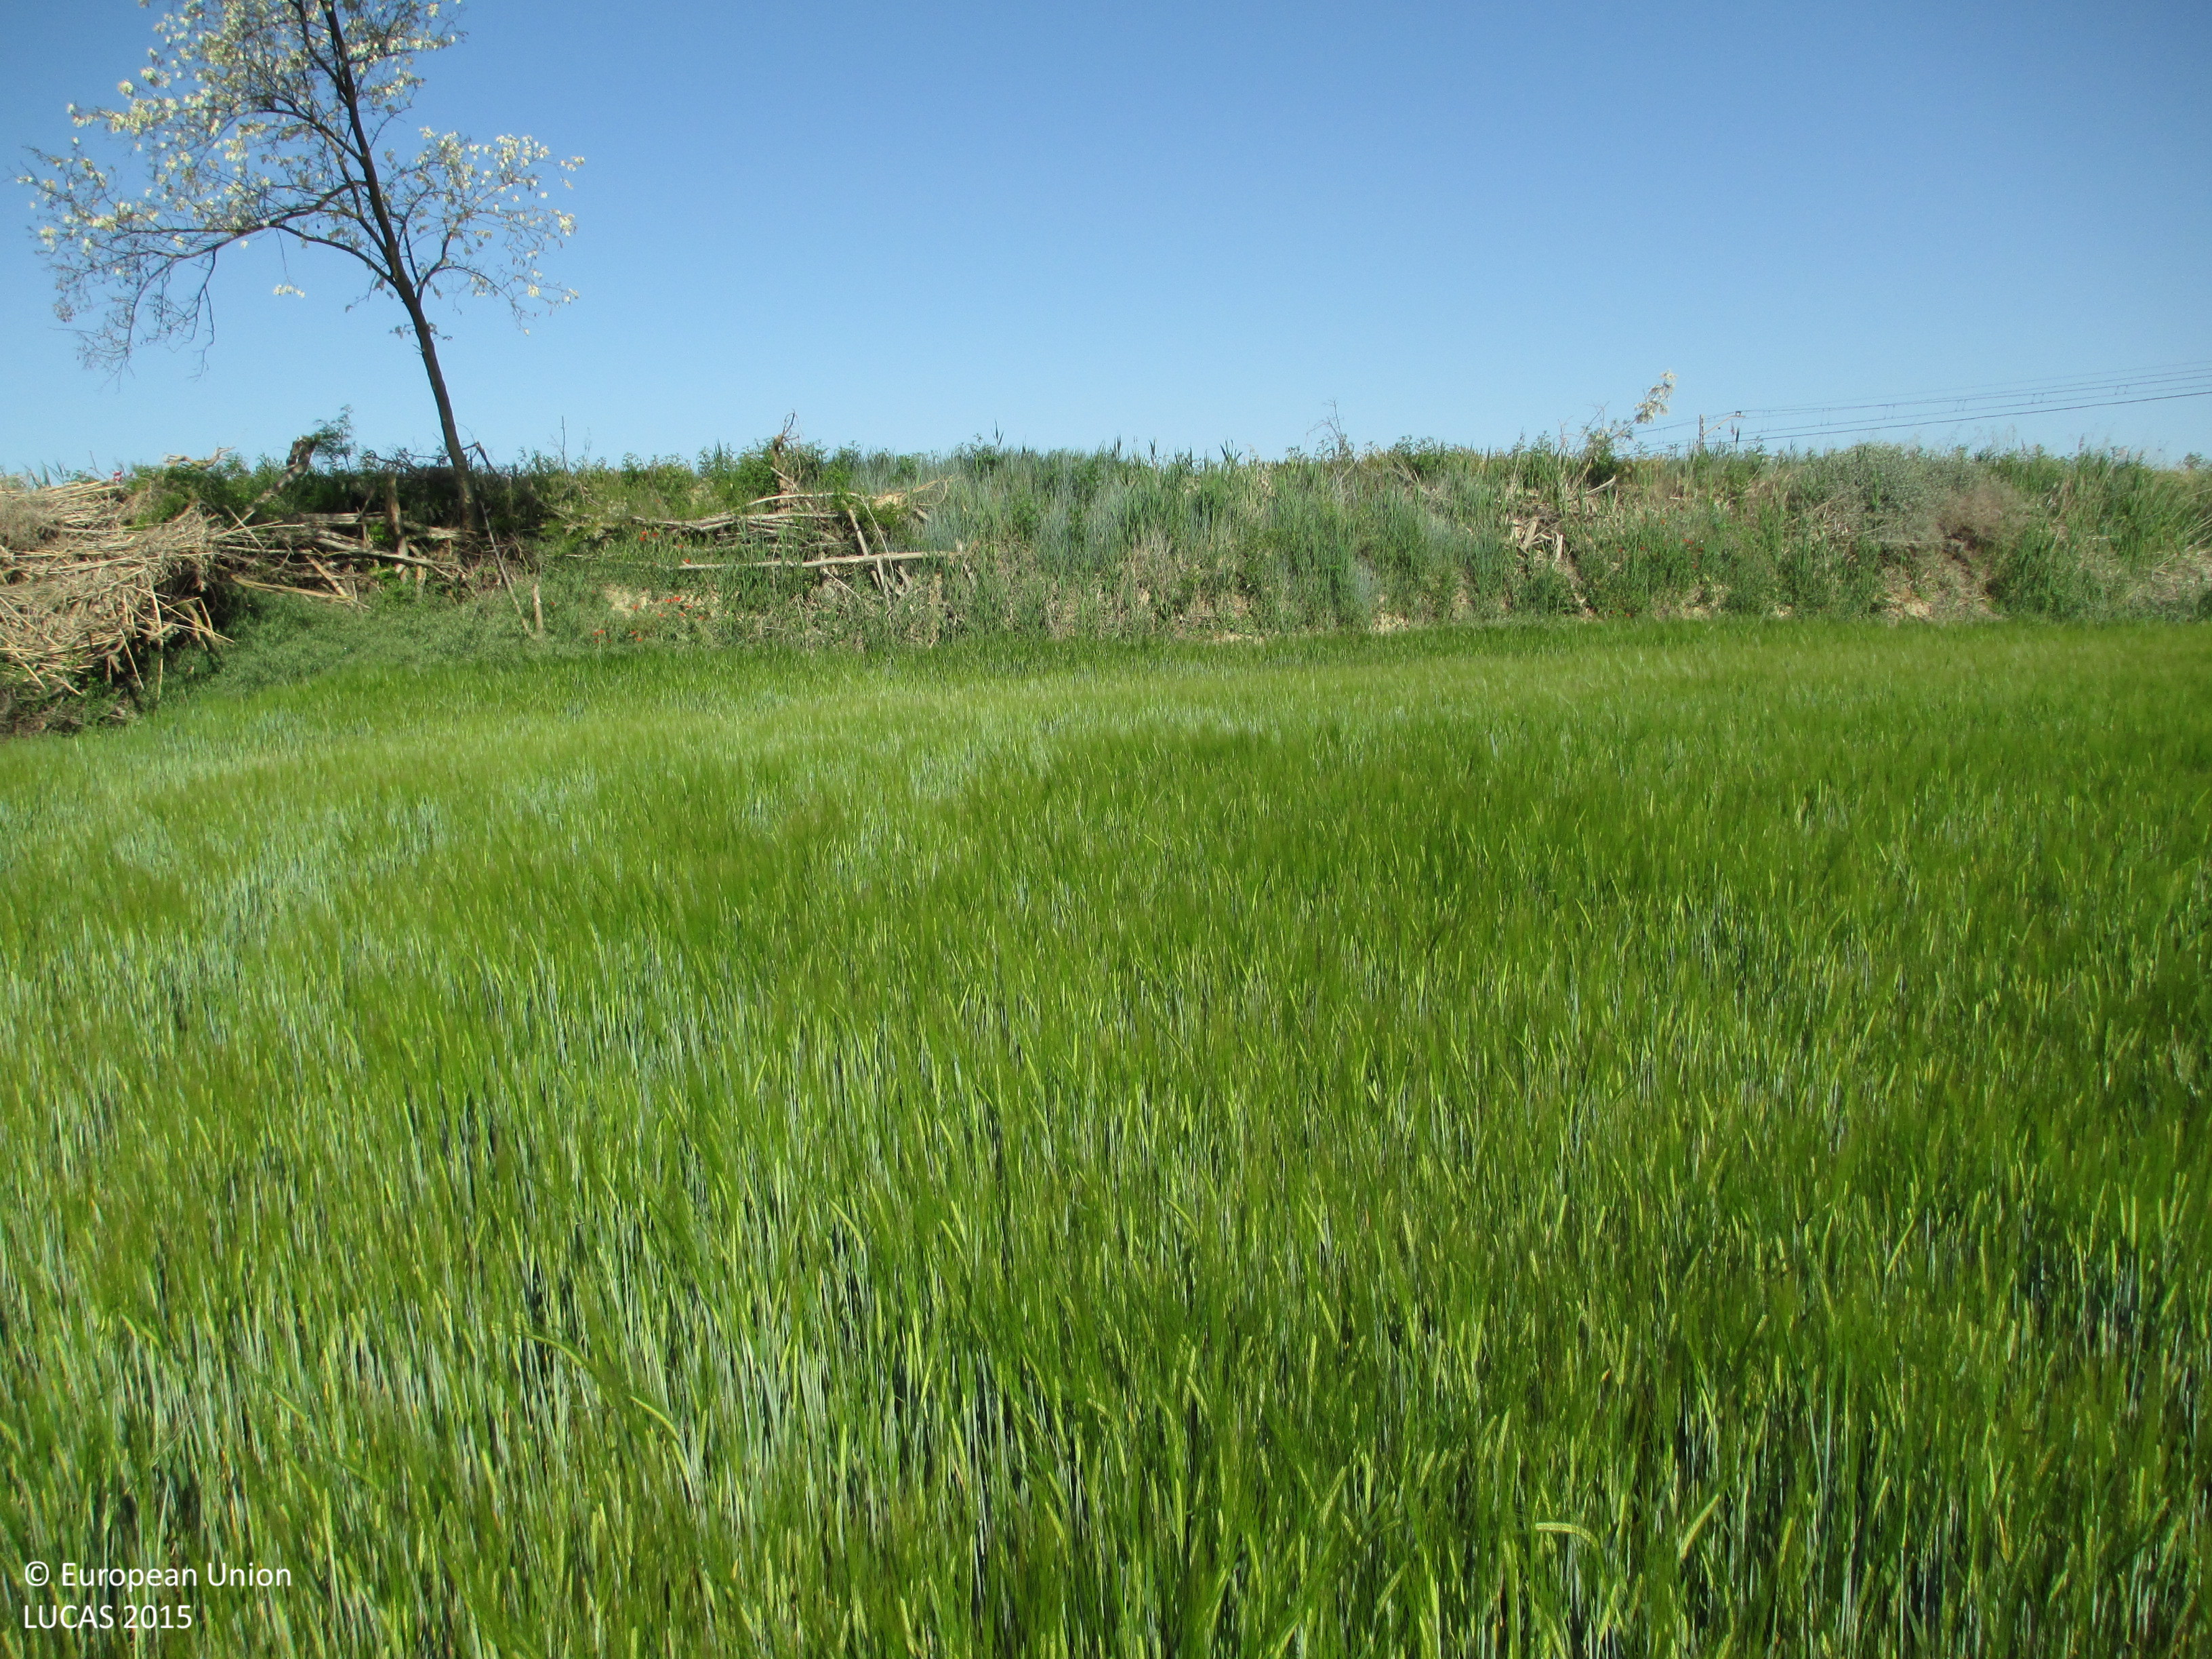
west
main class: Cropland
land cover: Barley
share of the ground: > 75 %
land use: Agriculture (excluding fallow land and kitchen gardens)
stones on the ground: < 10 %
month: May
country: ES
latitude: 41.9372
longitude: -0.3810
